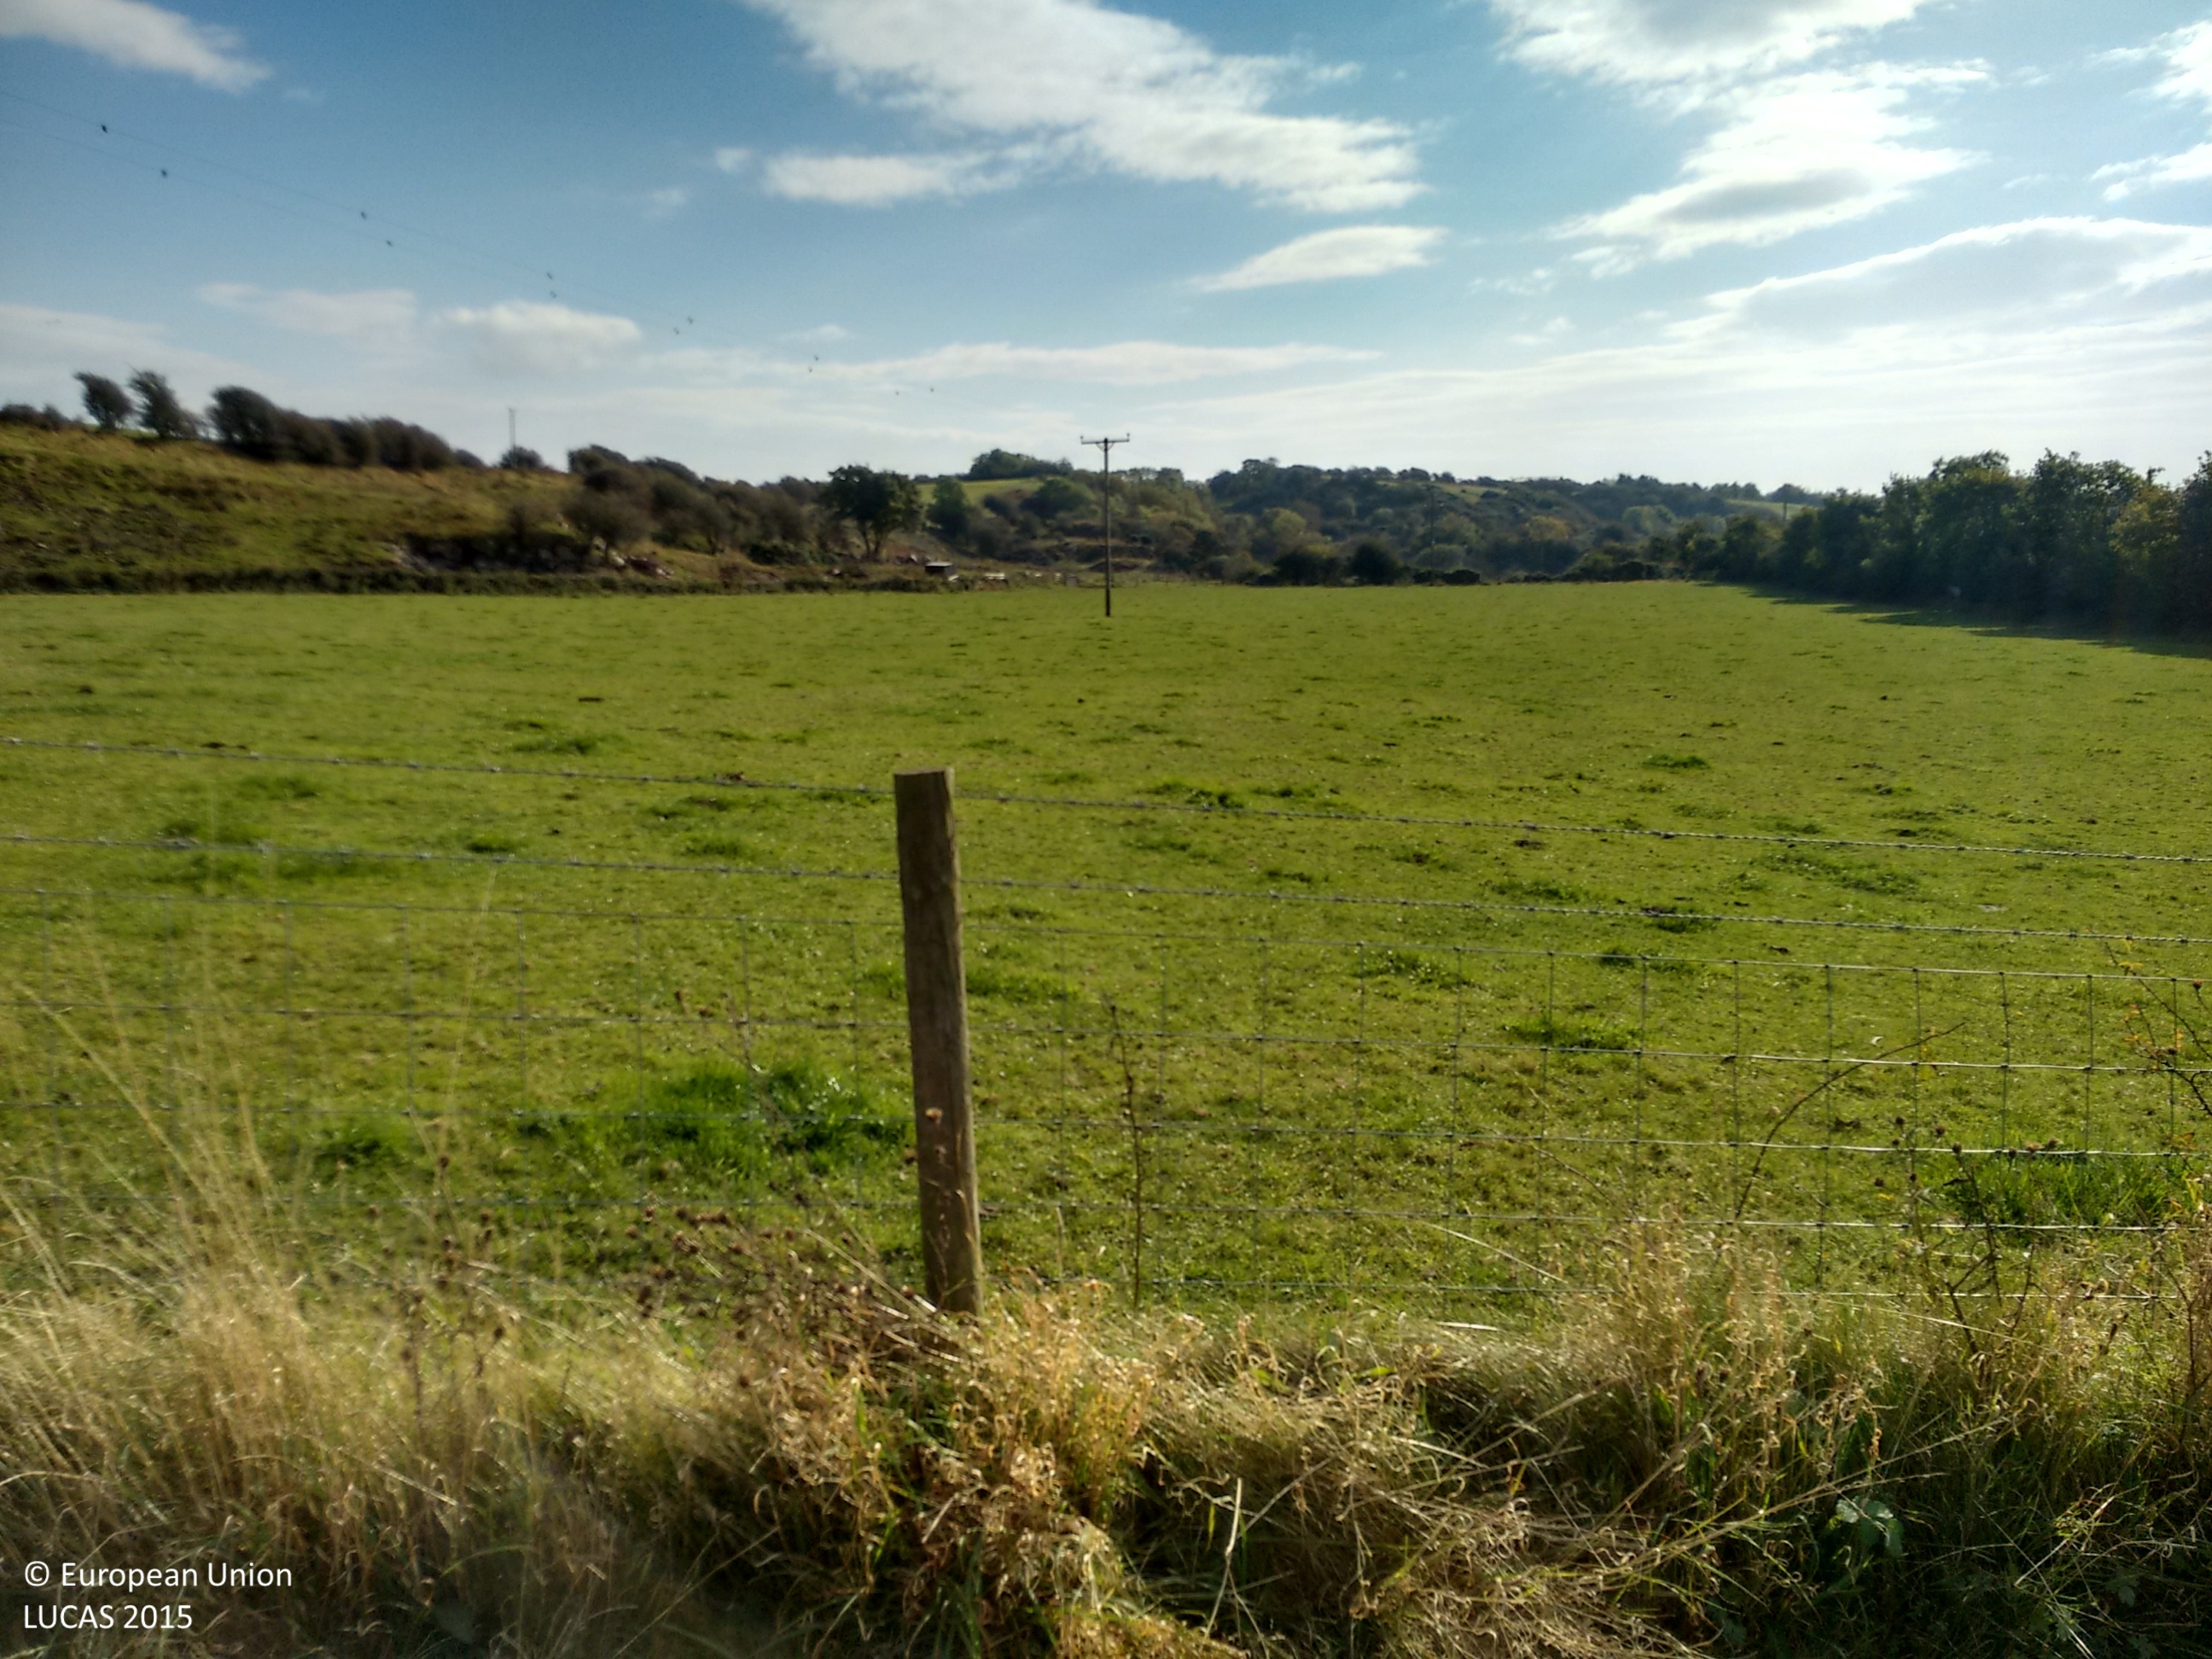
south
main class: Grassland
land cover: Grassland without tree/shrub cover
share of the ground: > 75 %
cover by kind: herbaceous plants 100 %
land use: Agriculture (excluding fallow land and kitchen gardens)
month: October
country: GB
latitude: 54.1731
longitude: -3.1743
